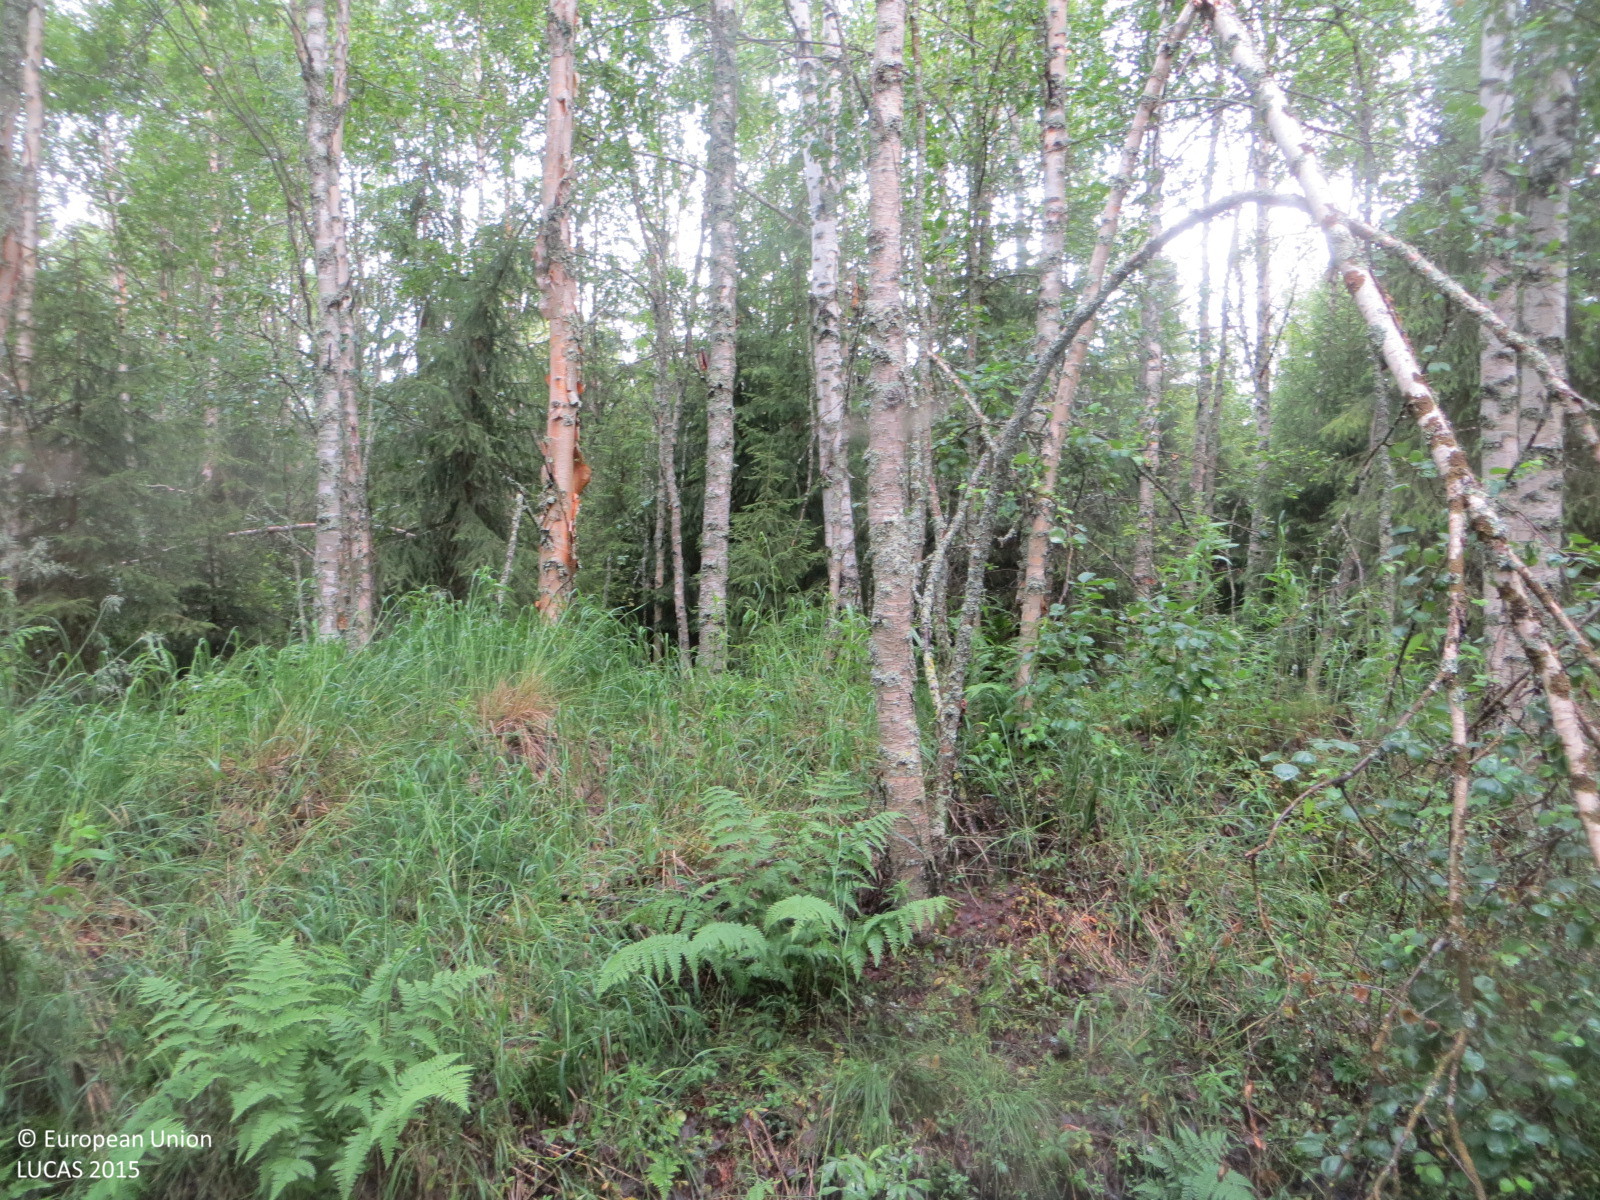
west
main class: Woodland
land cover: Spruce dominated mixed woodland
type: boreal forest
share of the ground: > 75 %
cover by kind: broadleaved forest trees 45 %, coniferous forest trees 30 %, shrubs 25 %
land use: Forestry
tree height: > 5 m
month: July
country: FI
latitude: 65.9304
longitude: 24.6227
